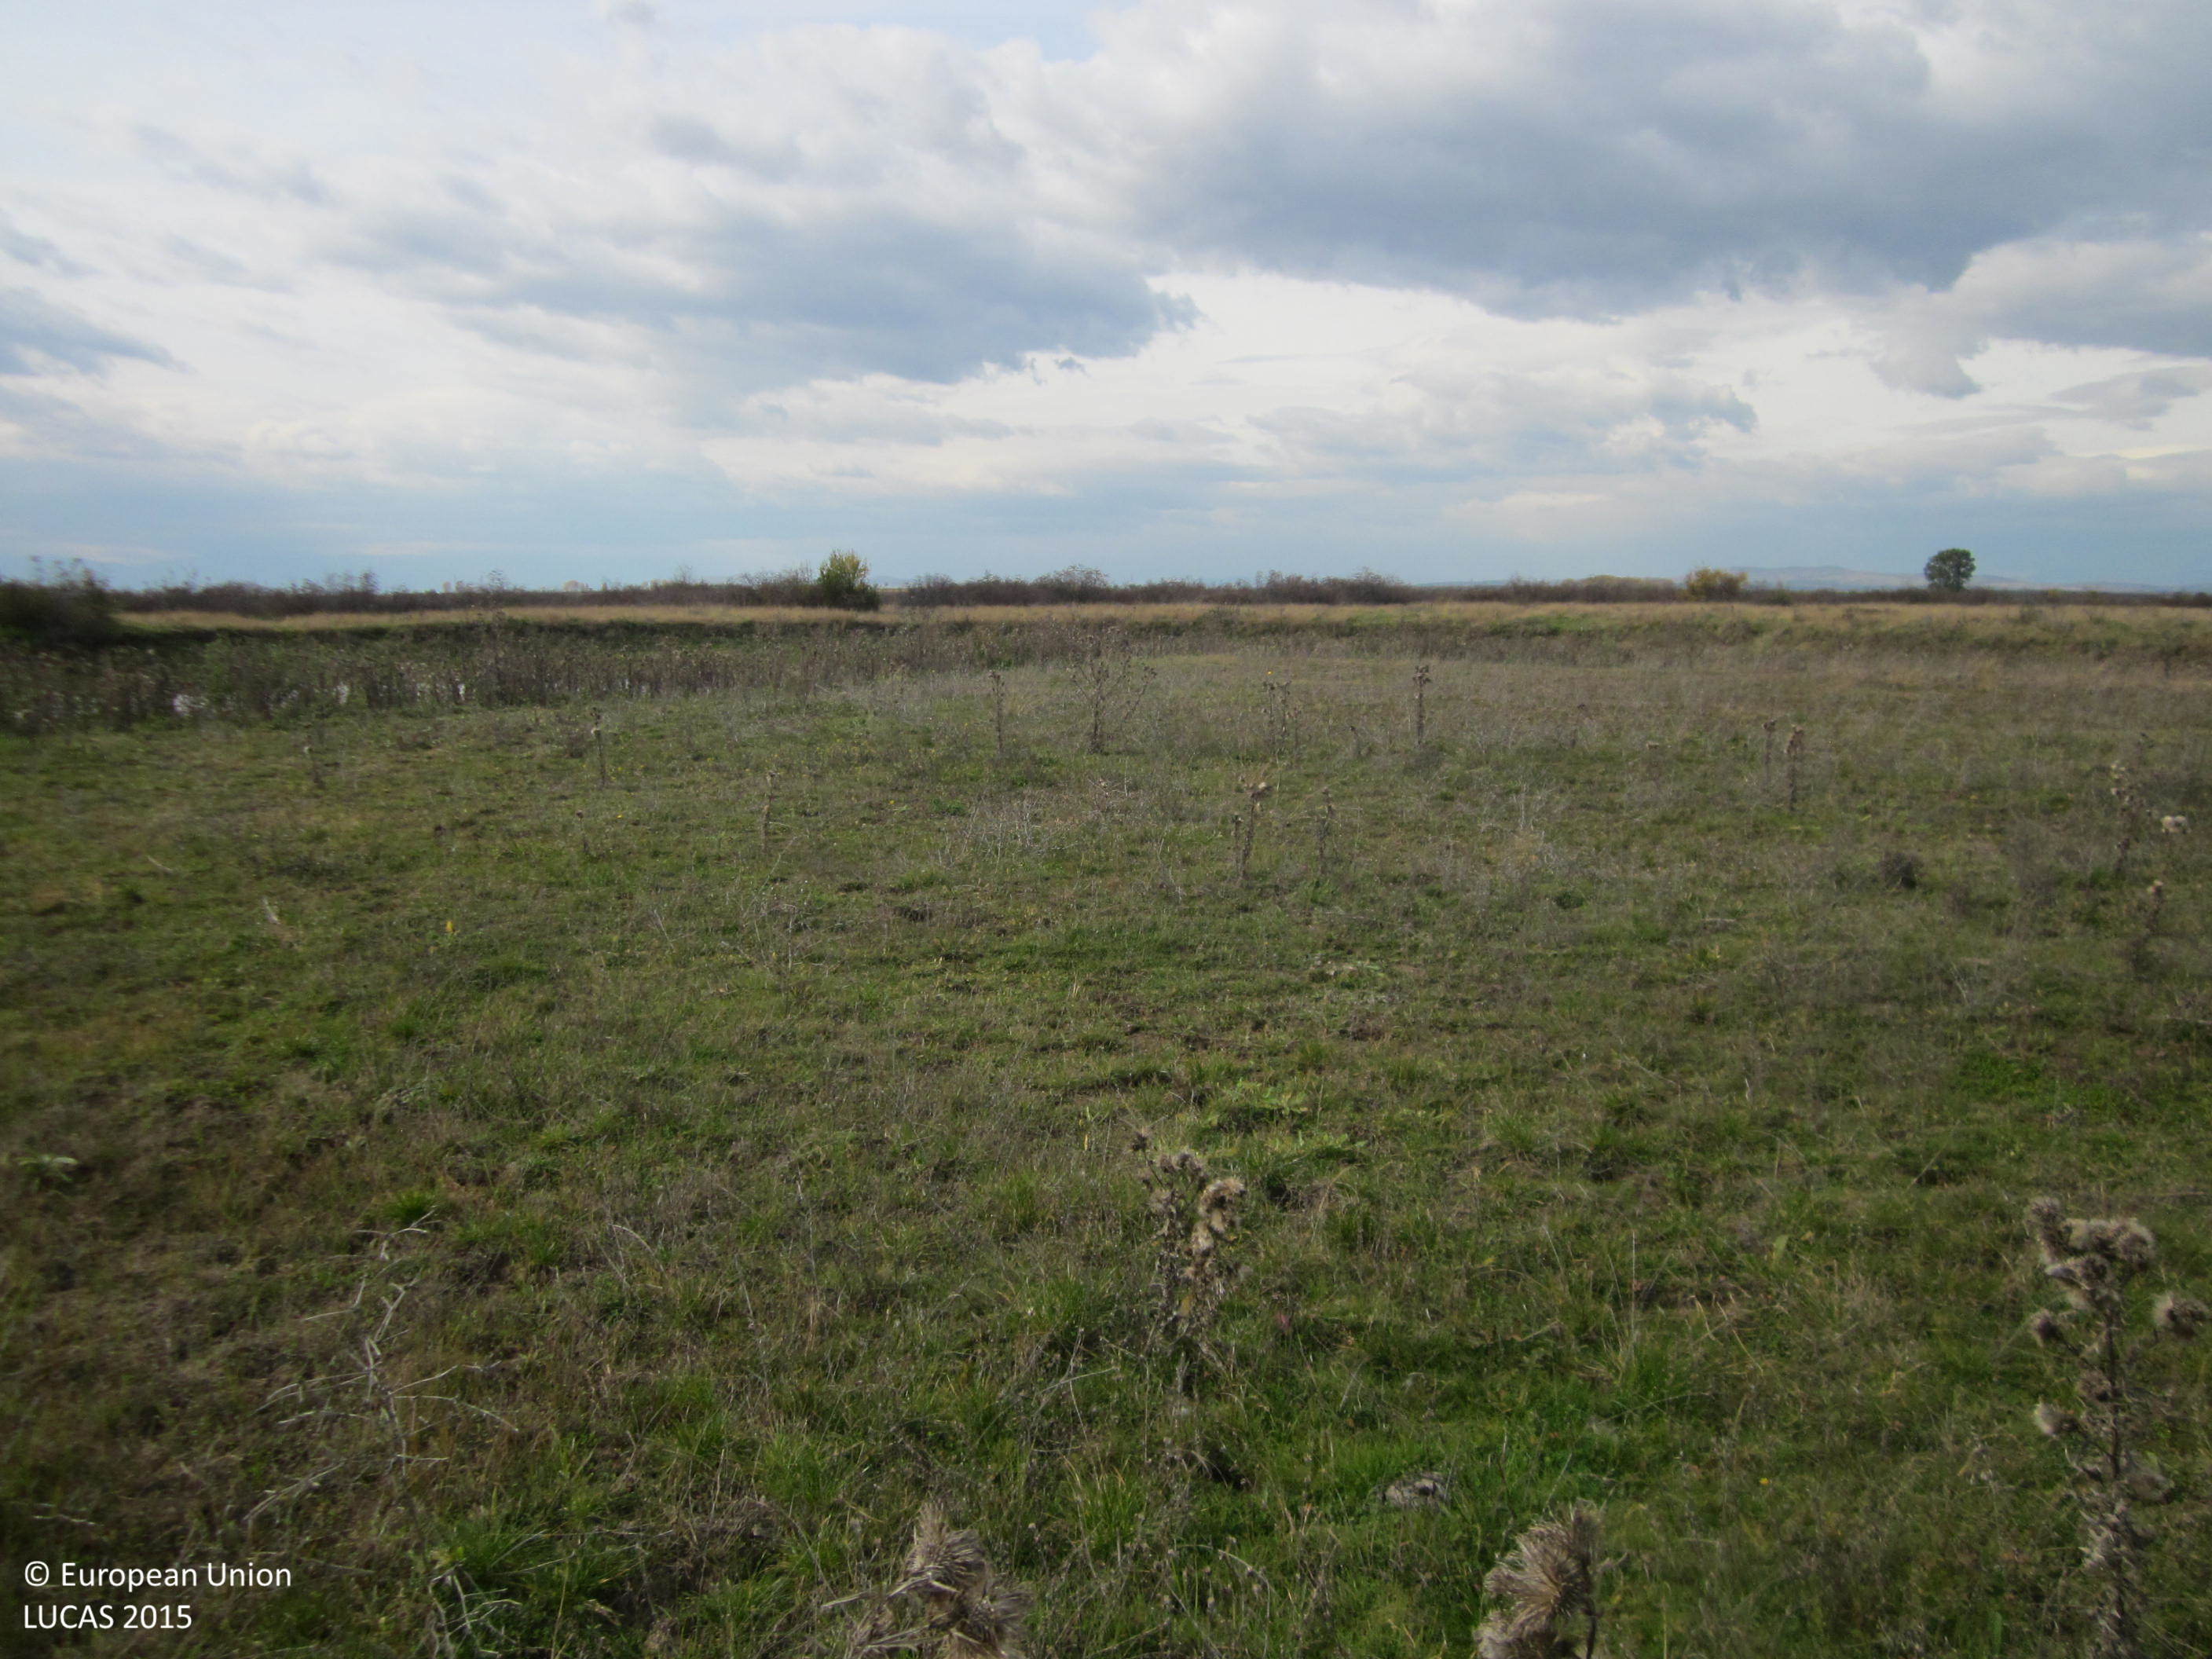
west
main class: Grassland
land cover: Grassland without tree/shrub cover
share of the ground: > 75 %
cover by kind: herbaceous plants 100 %
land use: Agriculture (excluding fallow land and kitchen gardens)
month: November
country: BG
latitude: 42.3402
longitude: 24.6042
